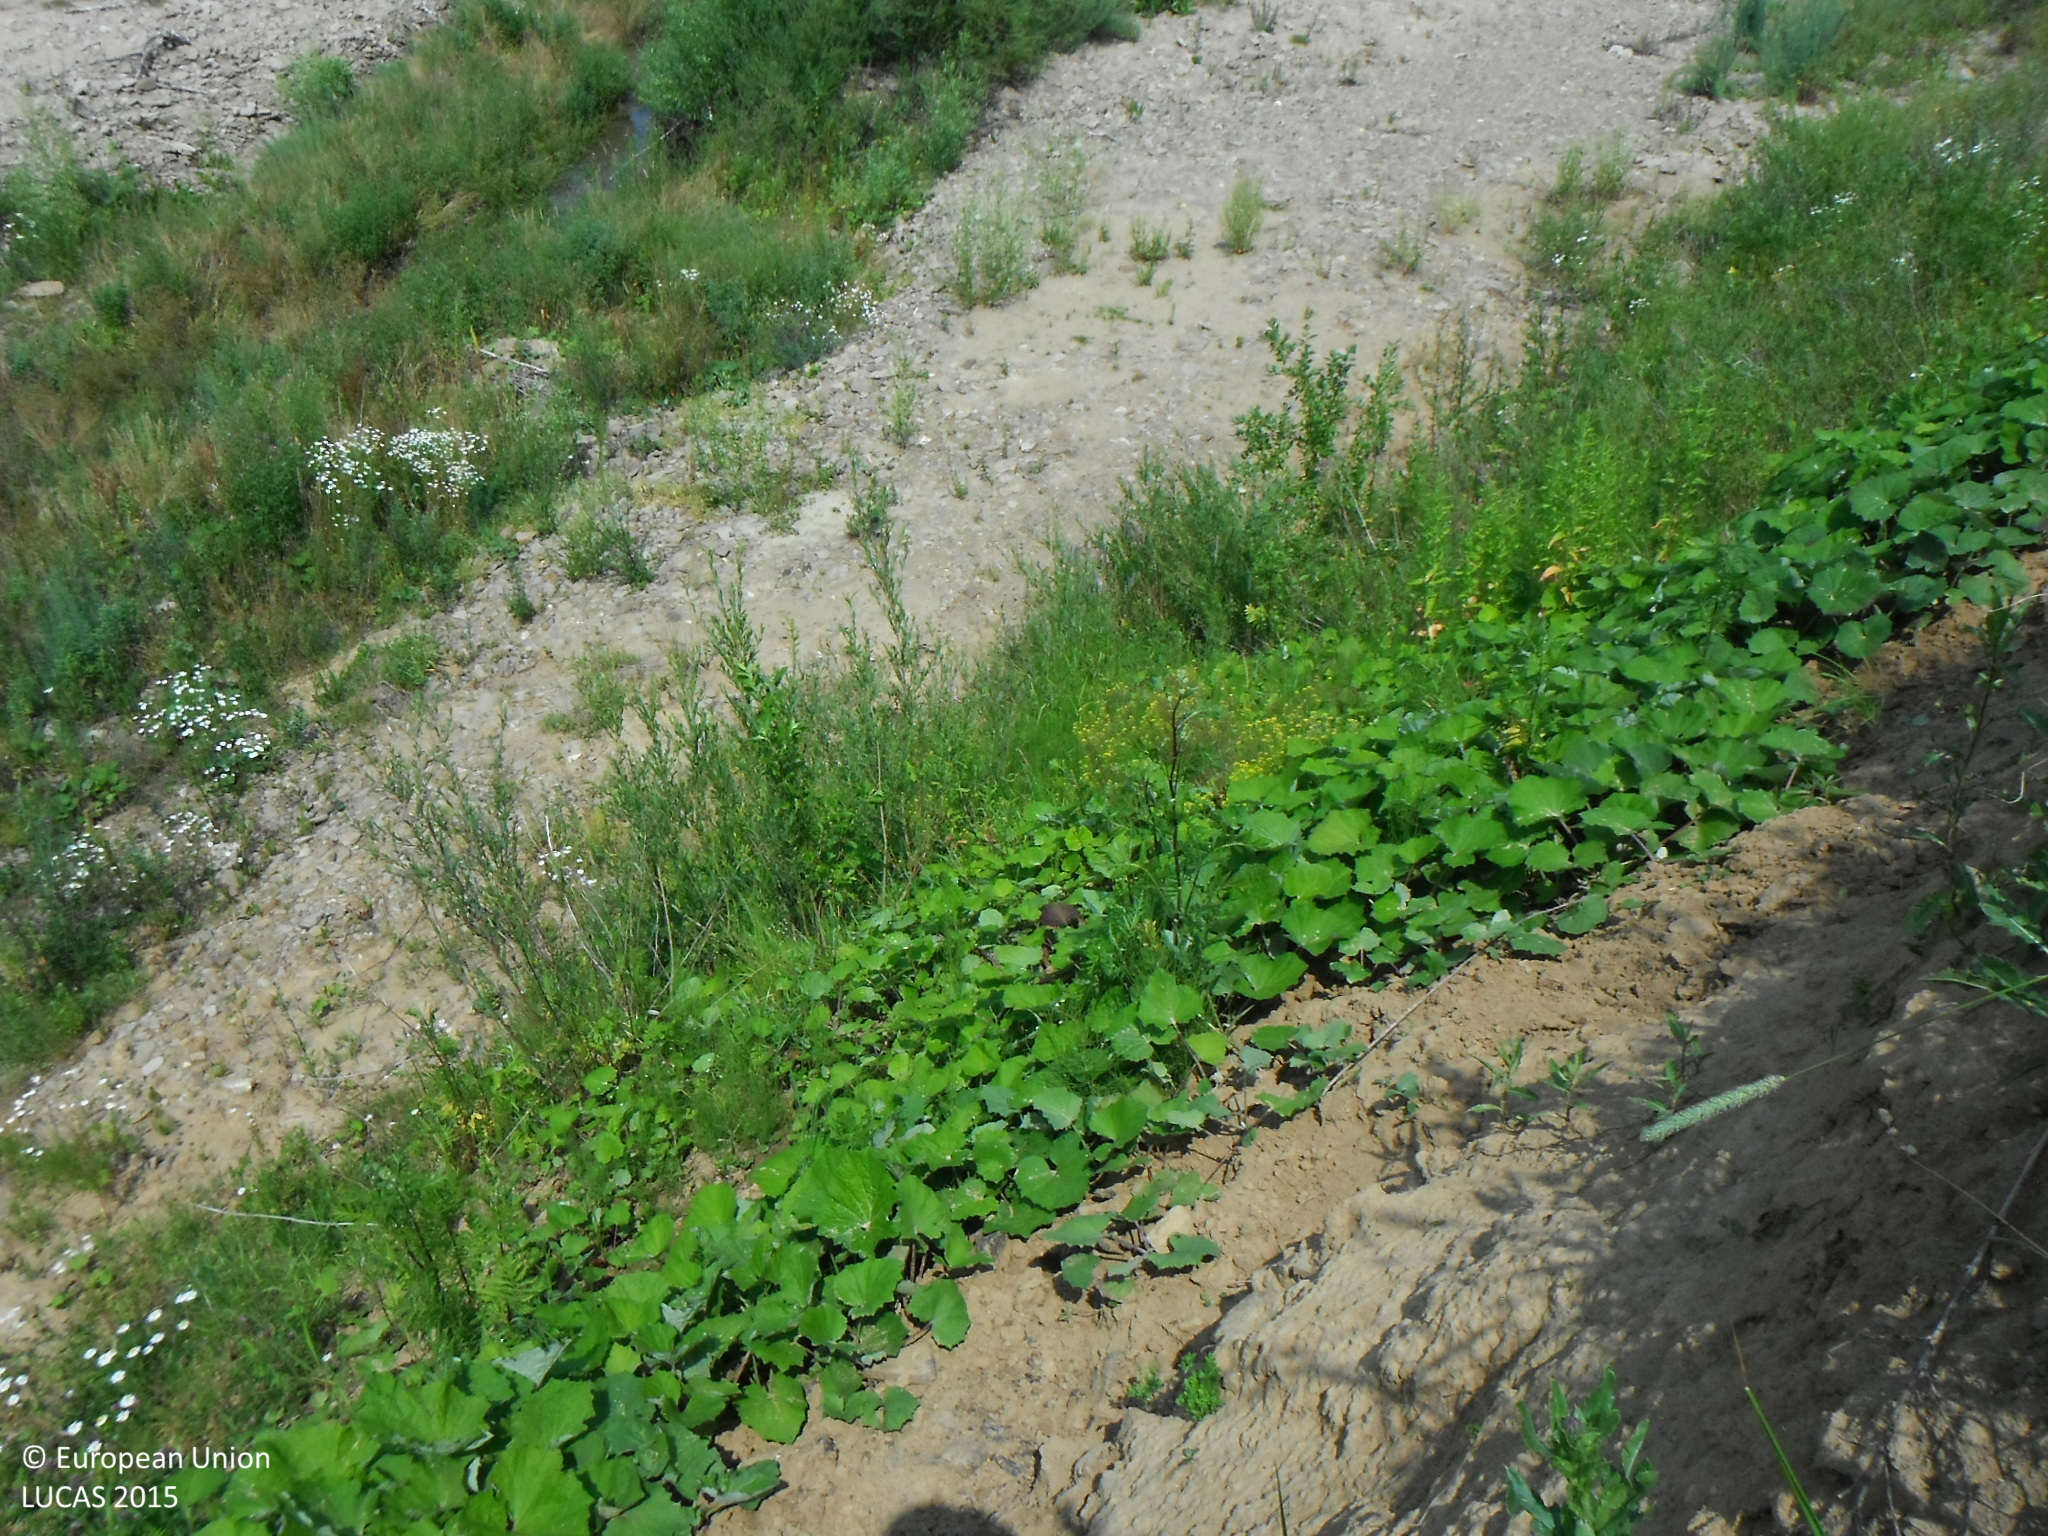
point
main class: Grassland
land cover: Spontaneously vegetated surfaces
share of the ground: > 75 %
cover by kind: herbaceous plants 85 %, unconsolidated bare surface 15 %
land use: Water supply and treatment
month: July
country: SK
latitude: 49.1406
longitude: 20.8280
